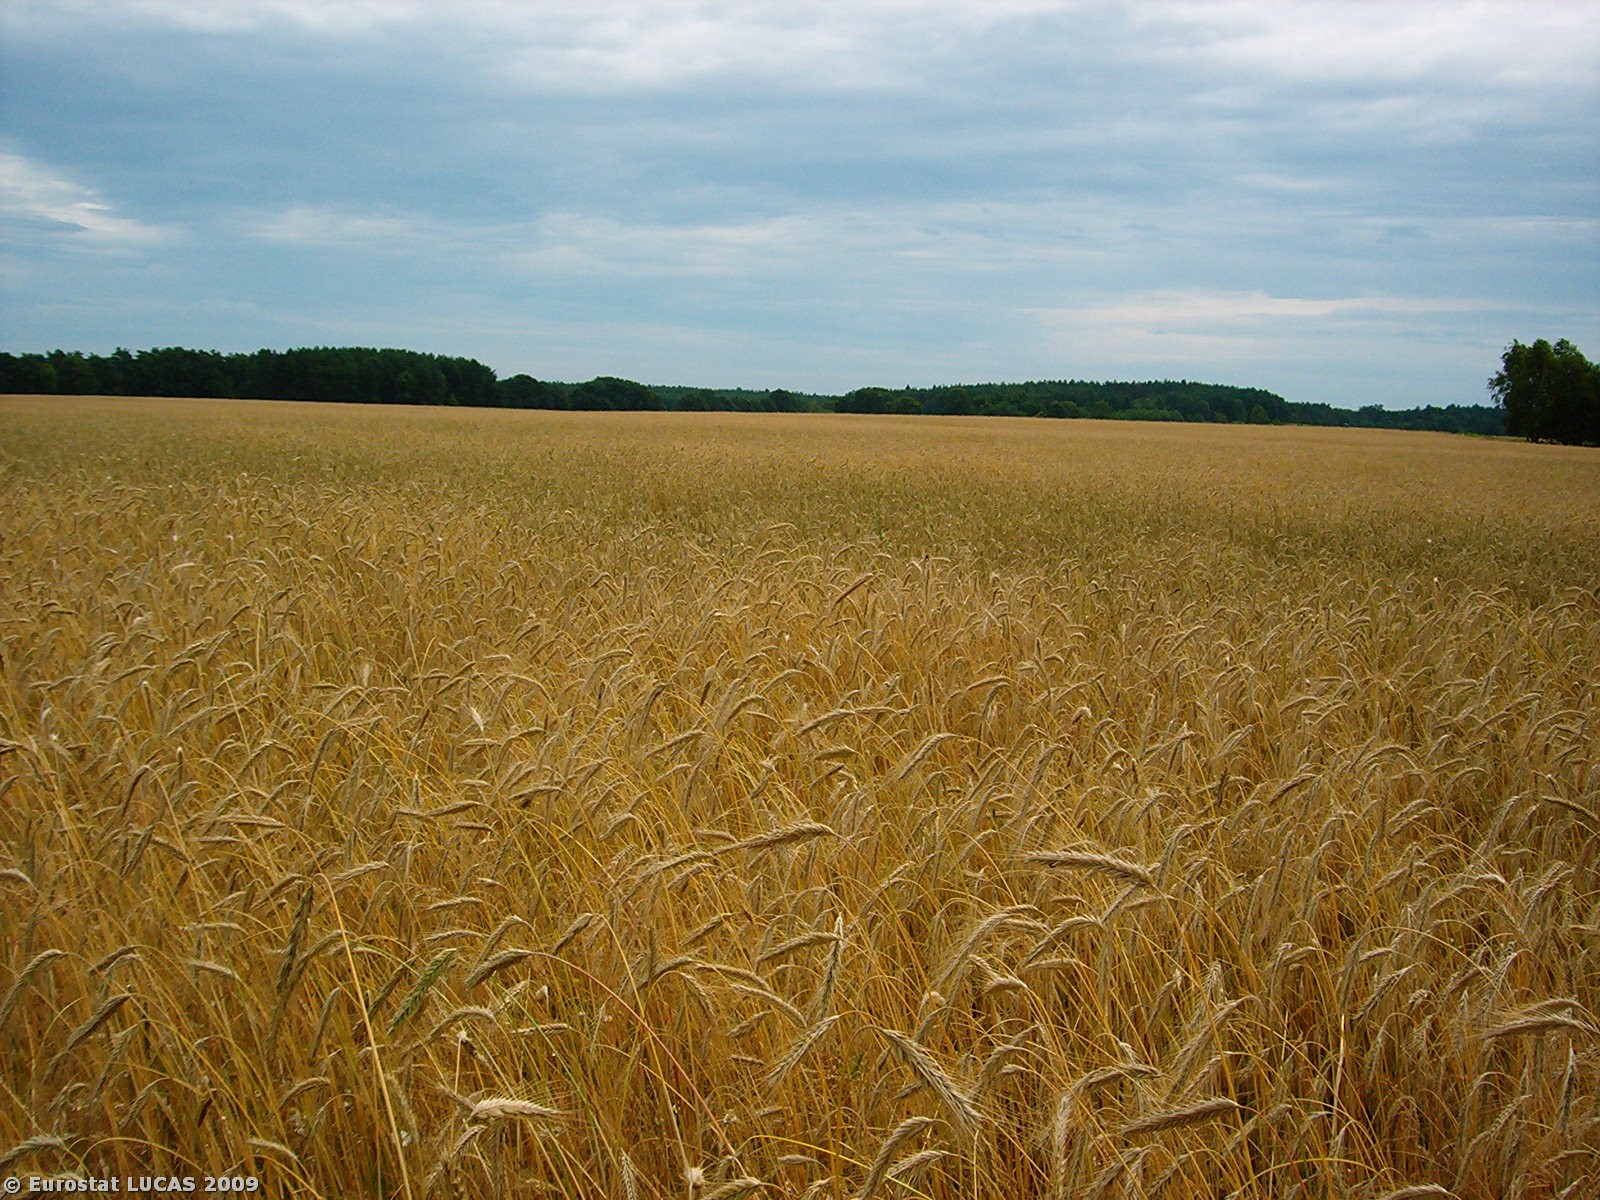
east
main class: Cropland
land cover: Triticale
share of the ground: > 75 %
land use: Agriculture (excluding fallow land and kitchen gardens)
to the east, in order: Triticale
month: July
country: PL
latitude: 52.3184
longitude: 15.1817
